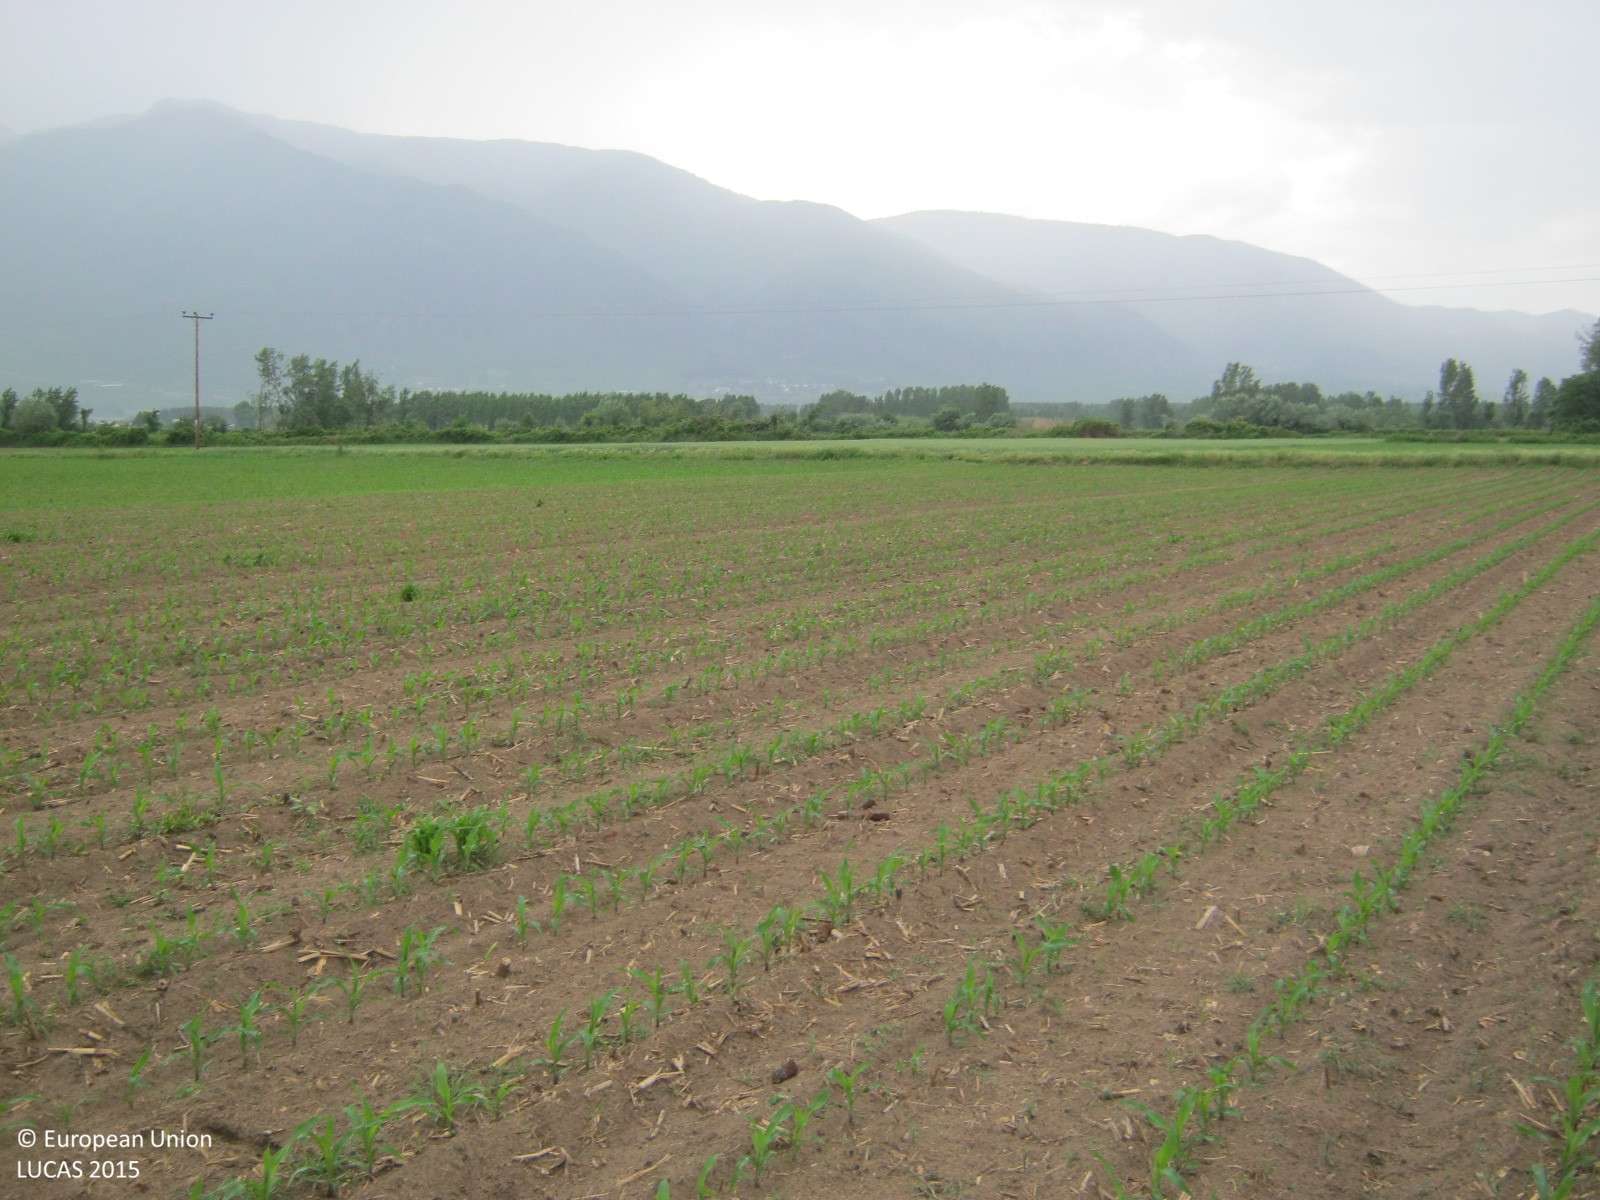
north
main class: Cropland
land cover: Maize
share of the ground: < 10 %
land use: Agriculture (excluding fallow land and kitchen gardens)
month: May
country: GR
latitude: 41.2341
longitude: 23.2249
